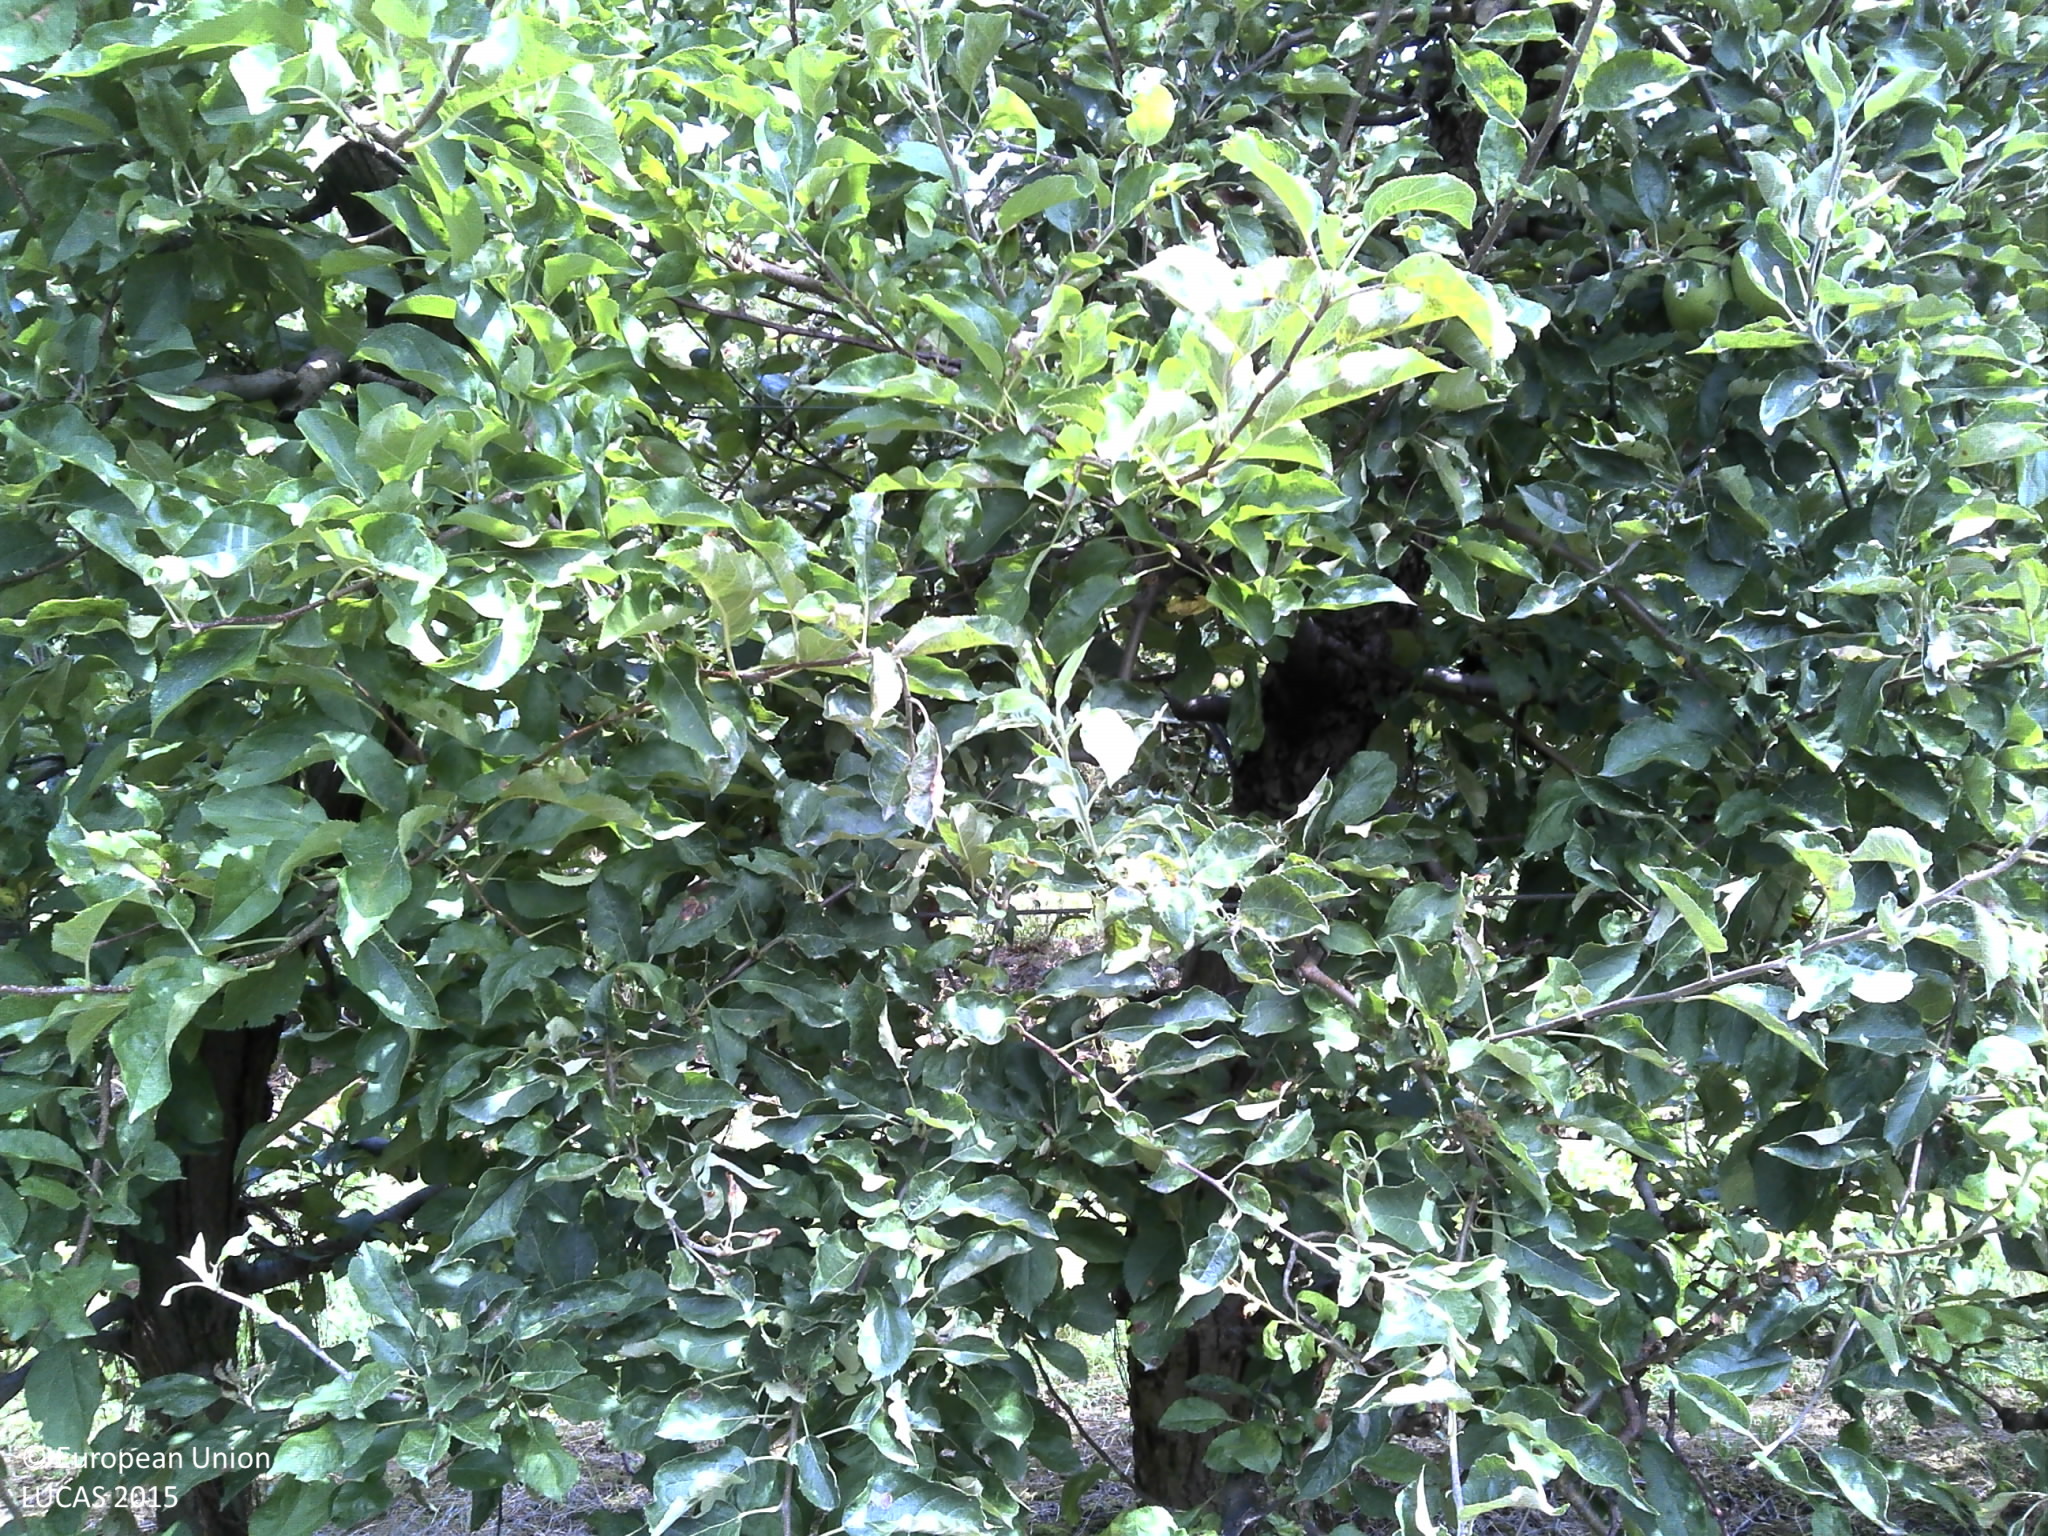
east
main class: Cropland
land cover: Apple fruit
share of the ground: > 75 %
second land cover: Spontaneously vegetated surfaces
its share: > 75 %
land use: Kitchen garden
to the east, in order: Apple fruit; Spontaneously vegetated surfaces; Fences; Tracks; Grassland without tree/shrub cover; Other fruit trees and berries; Fences; Other fresh vegetables; Other fruit trees and berries; Artificial constructions in urban areas; Other fresh vegetables; Fences; Other fruit trees and berries; Grassland with sparse tree/shrub cover
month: July
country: HR
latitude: 45.6393
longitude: 16.6318
